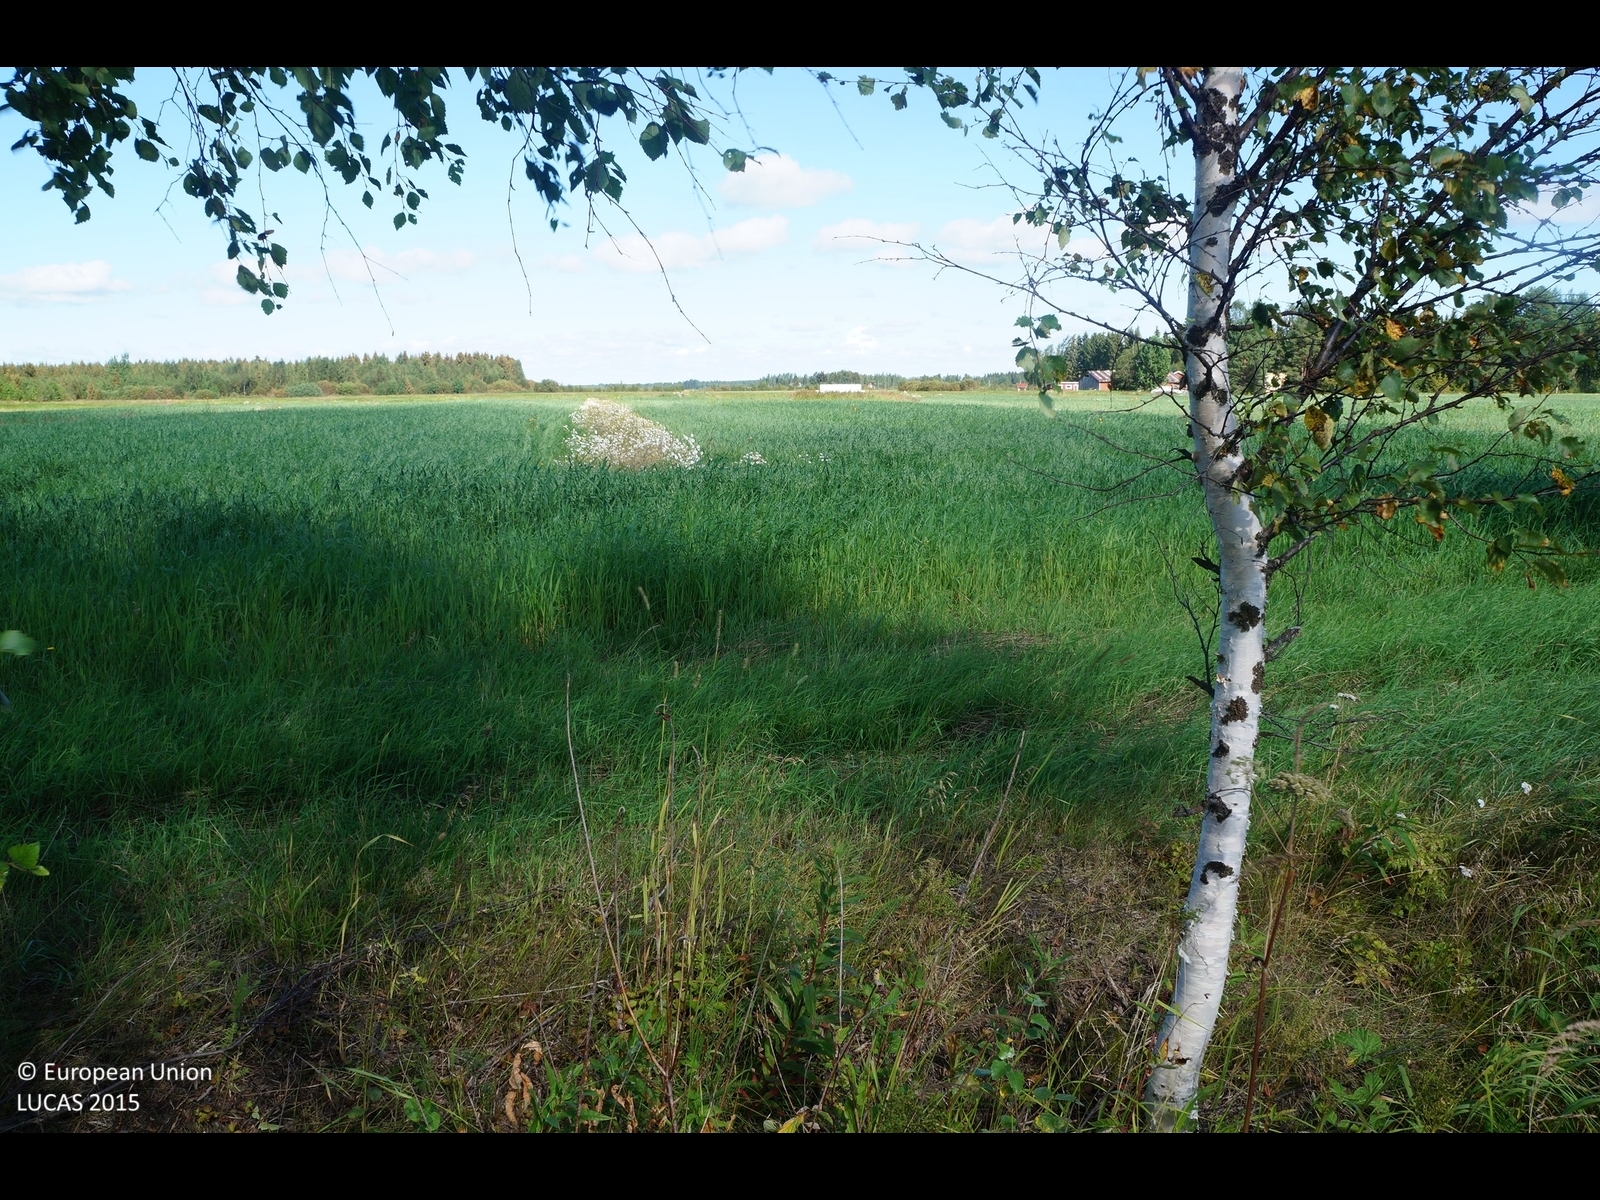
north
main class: Cropland
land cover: Oats
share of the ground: > 75 %
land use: Agriculture (excluding fallow land and kitchen gardens)
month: August
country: FI
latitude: 64.7585
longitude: 25.4922
